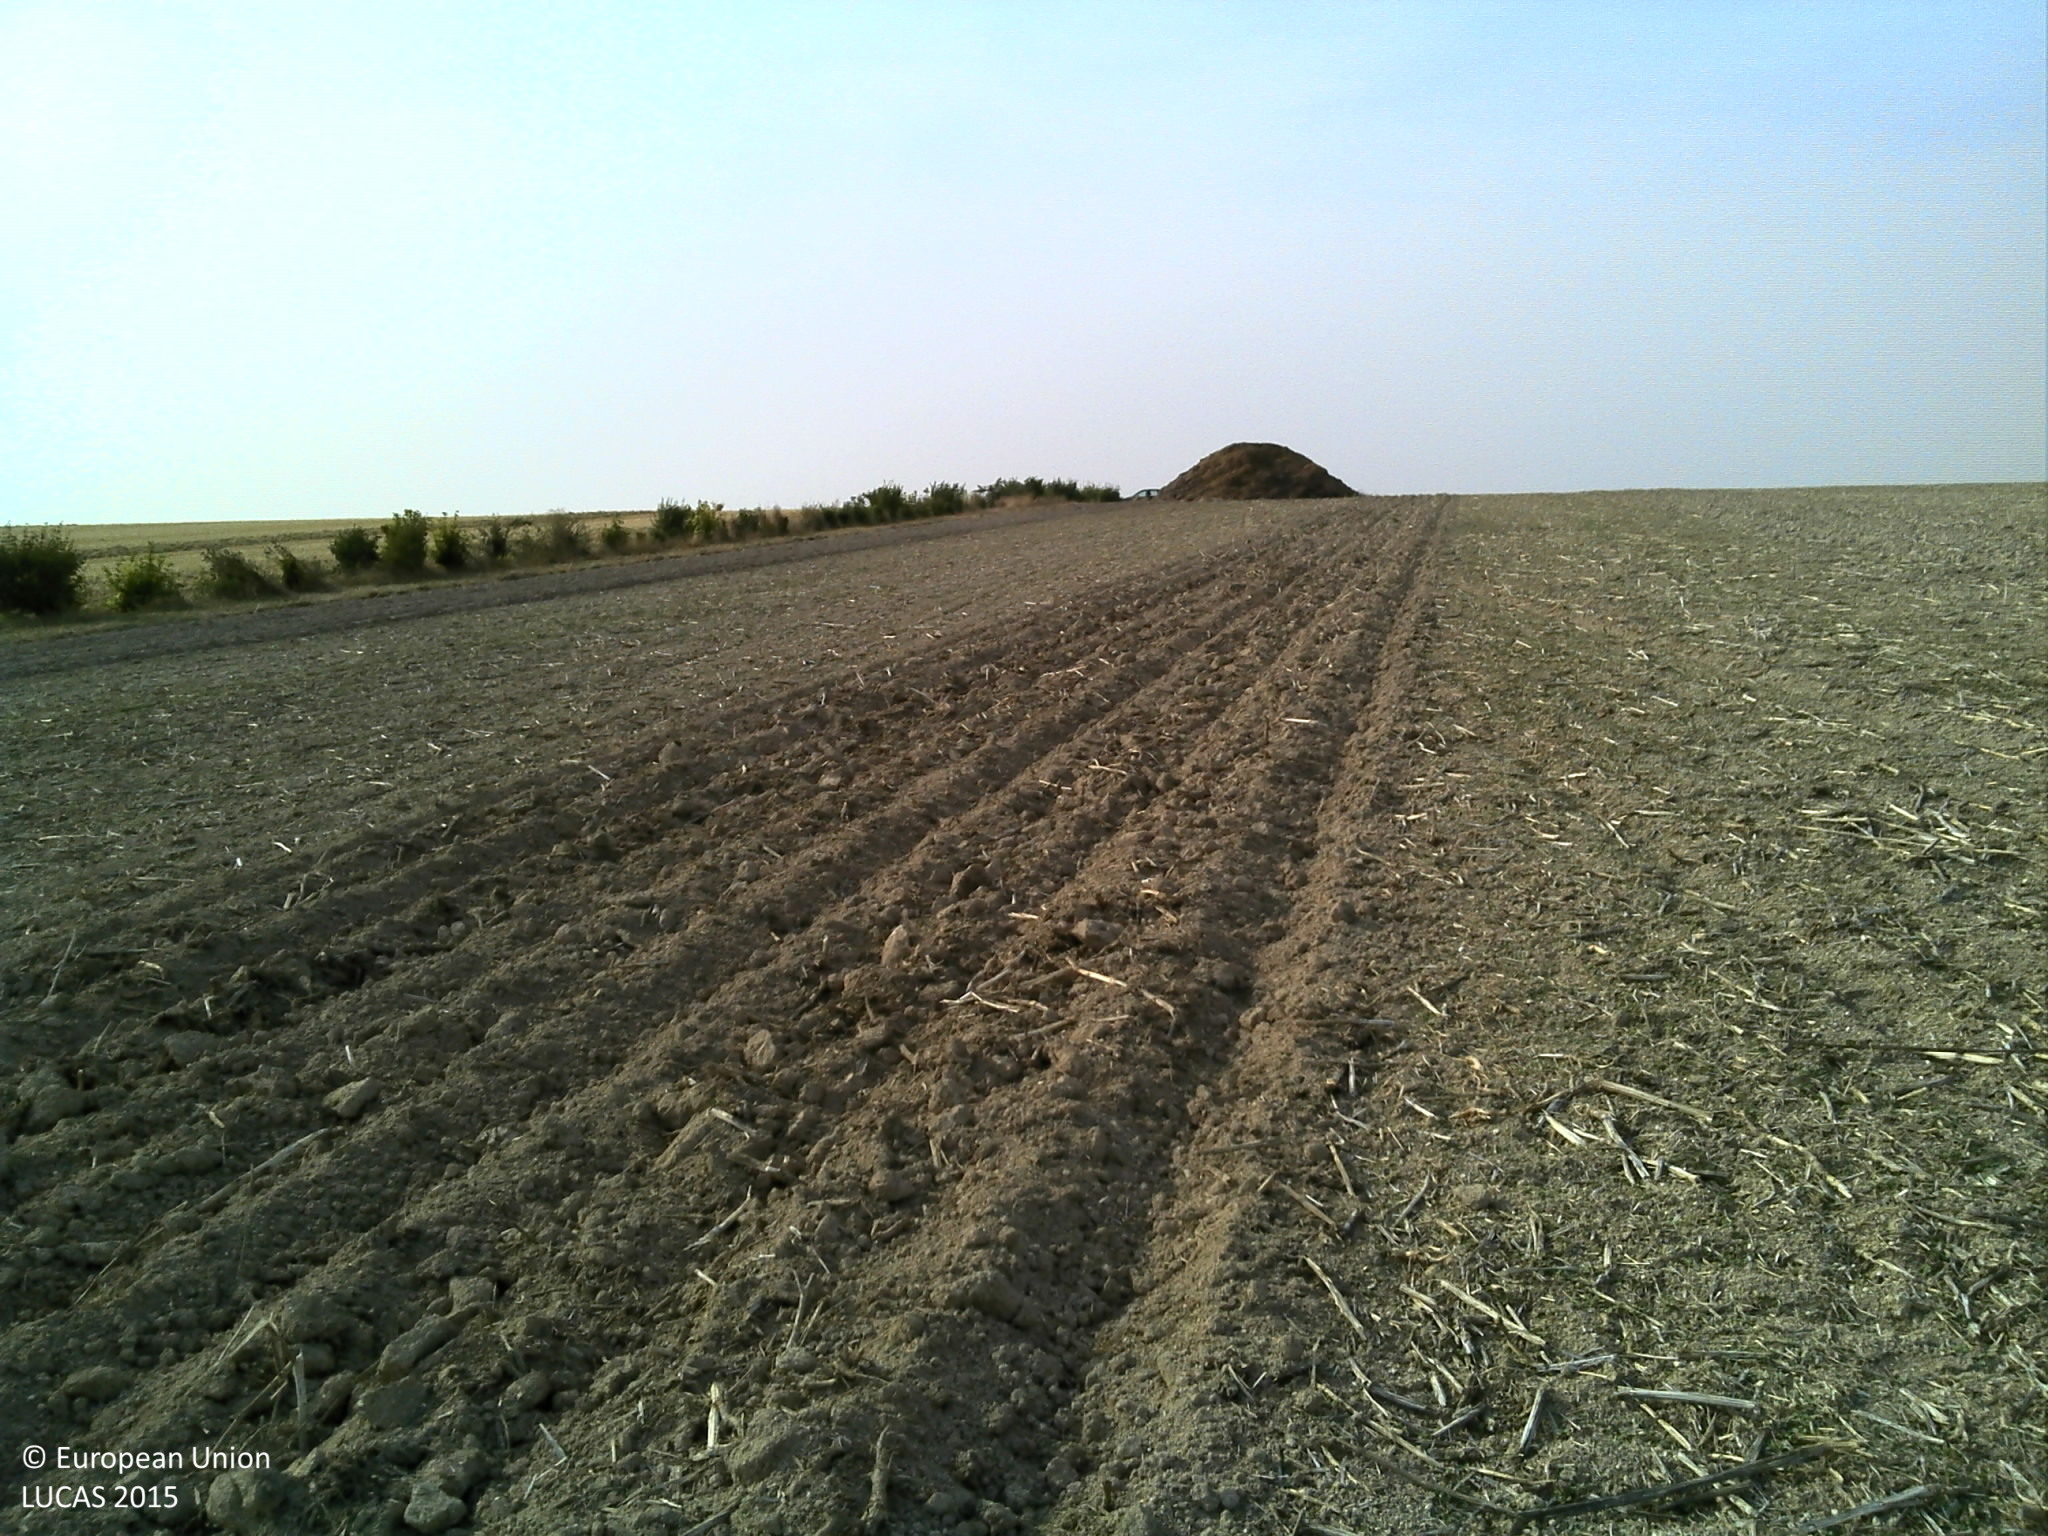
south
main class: Cropland
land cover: Rape and turnip rape
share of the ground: > 75 %
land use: Agriculture (excluding fallow land and kitchen gardens)
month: August
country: FR
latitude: 49.0080
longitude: 4.5420
